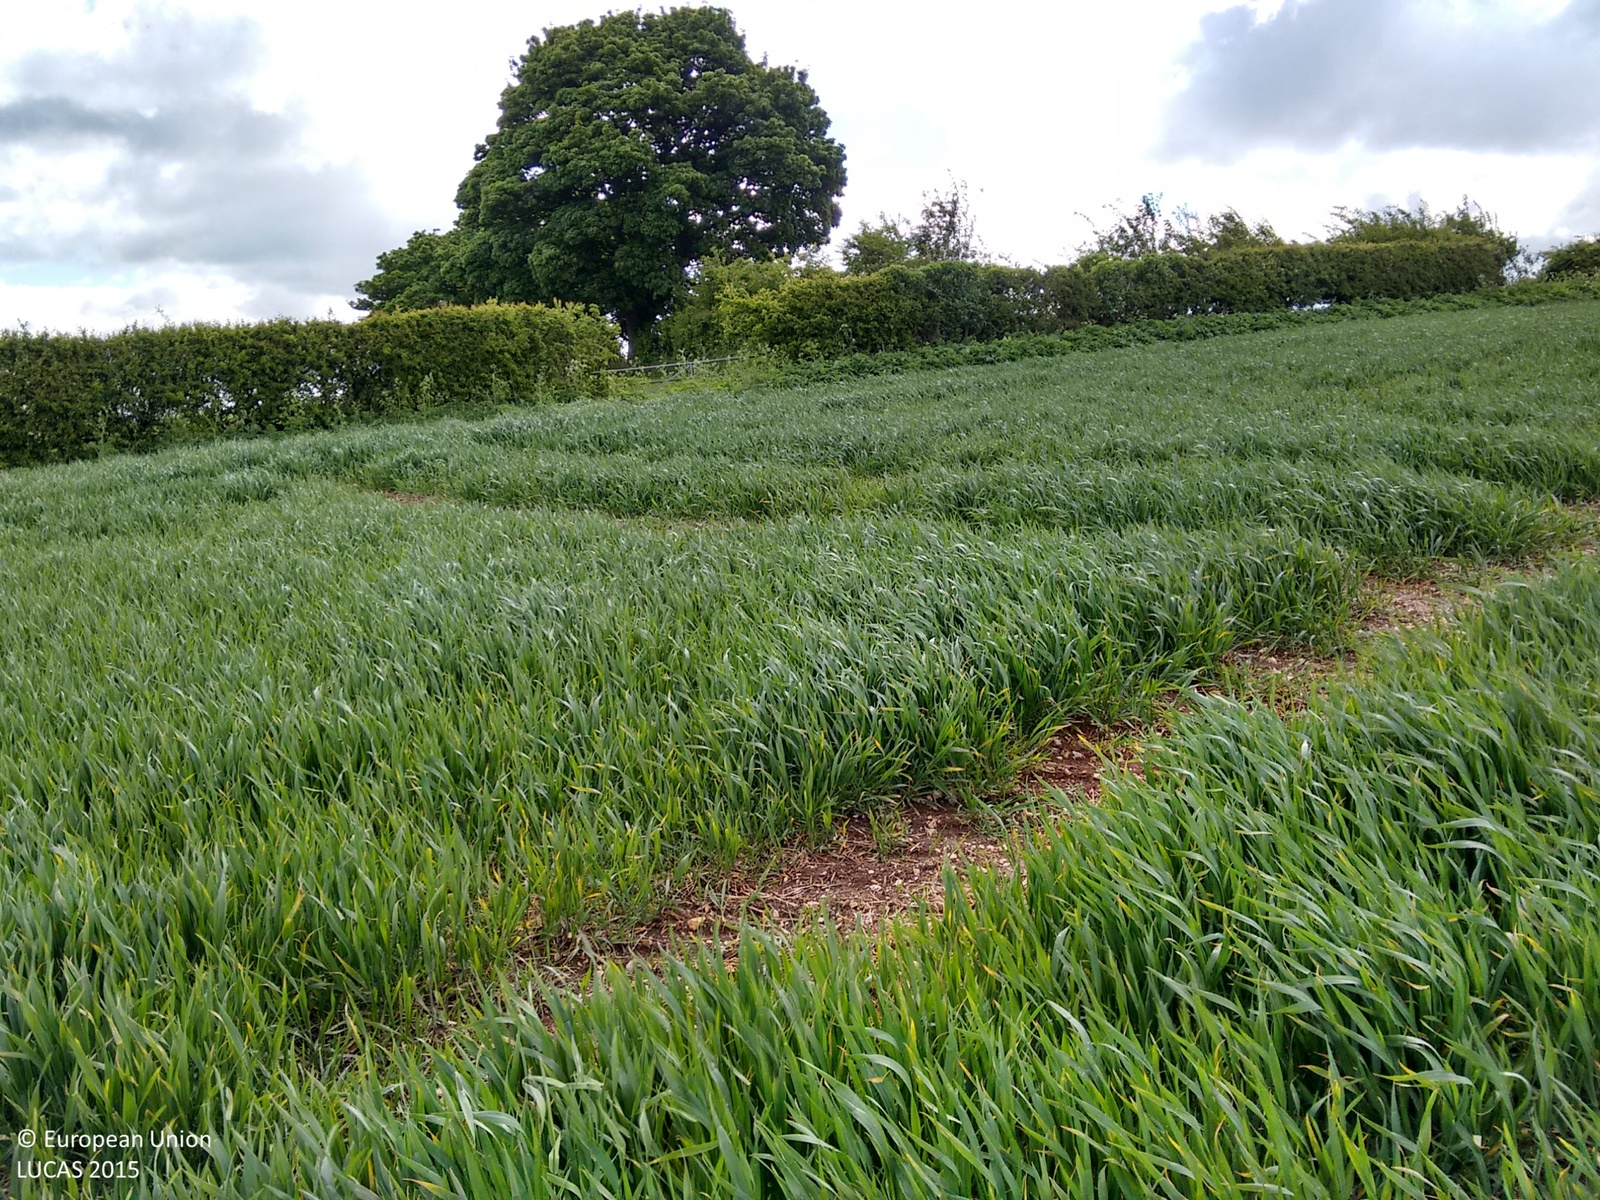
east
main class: Cropland
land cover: Common wheat
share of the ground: > 75 %
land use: Agriculture (excluding fallow land and kitchen gardens)
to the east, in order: Common wheat; Grass margins; Managed hedges; Grassland without tree/shrub cover; Fences; Single bushes/trees; Grass margins; Common wheat
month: May
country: GB
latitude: 53.3985
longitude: -0.0638
